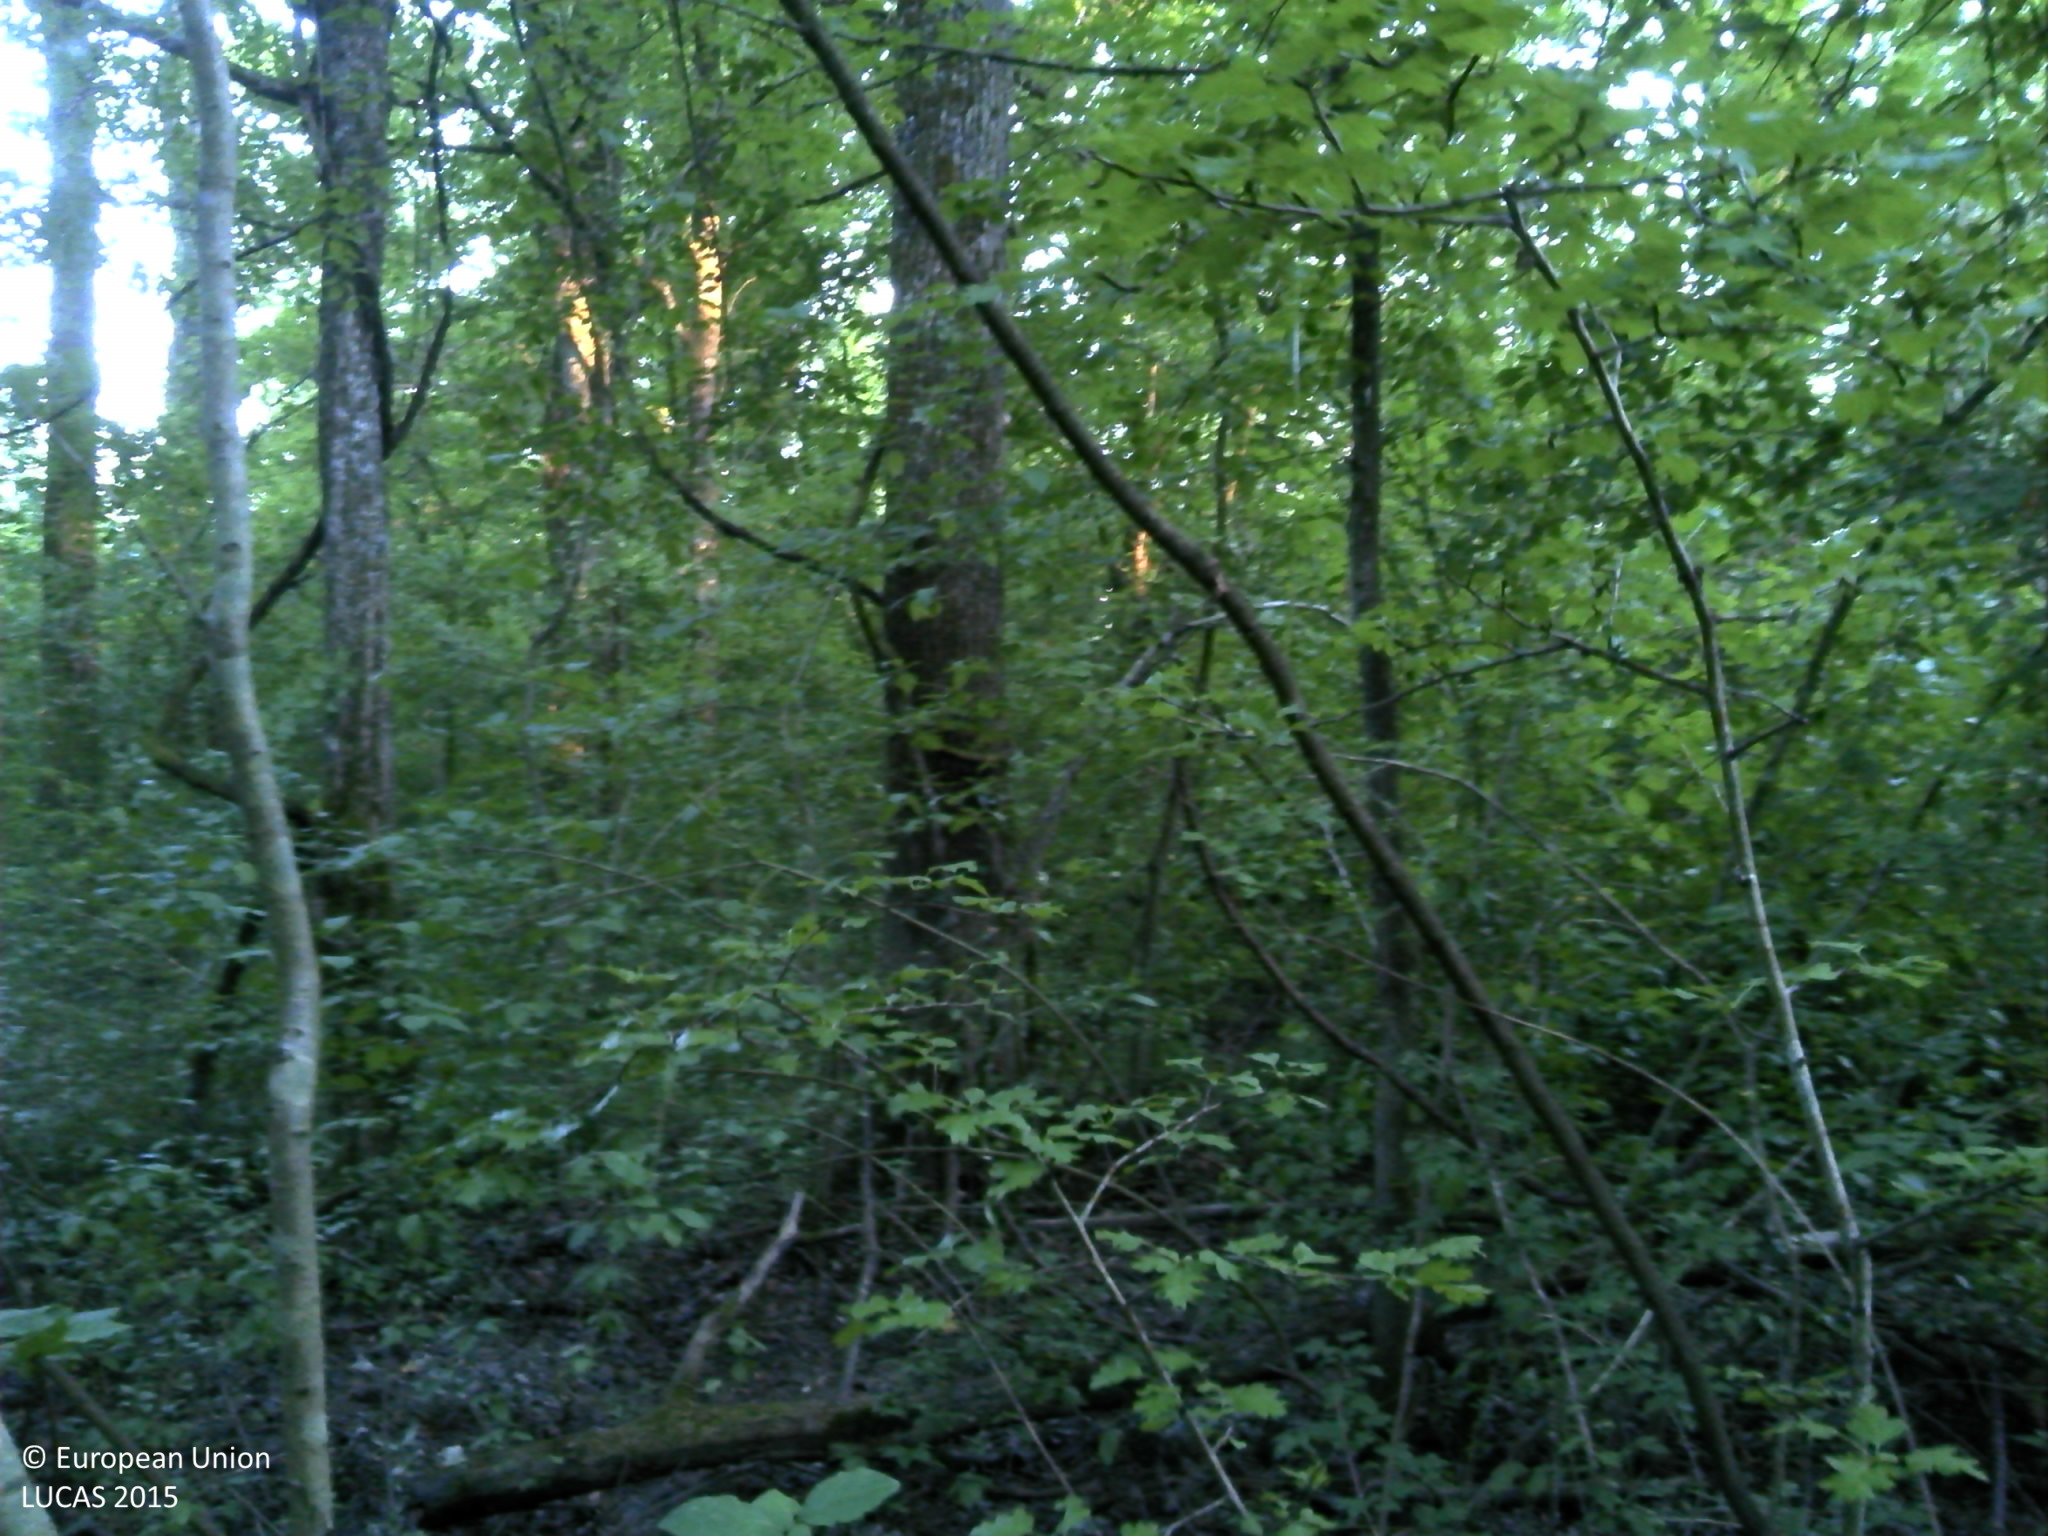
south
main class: Woodland
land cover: Broadleaved woodland
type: acidophilous oak and oak-birch forest
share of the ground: > 75 %
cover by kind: broadleaved forest trees 100 %
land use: Forestry
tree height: > 5 m
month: August
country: HR
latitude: 45.5247
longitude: 16.4381
